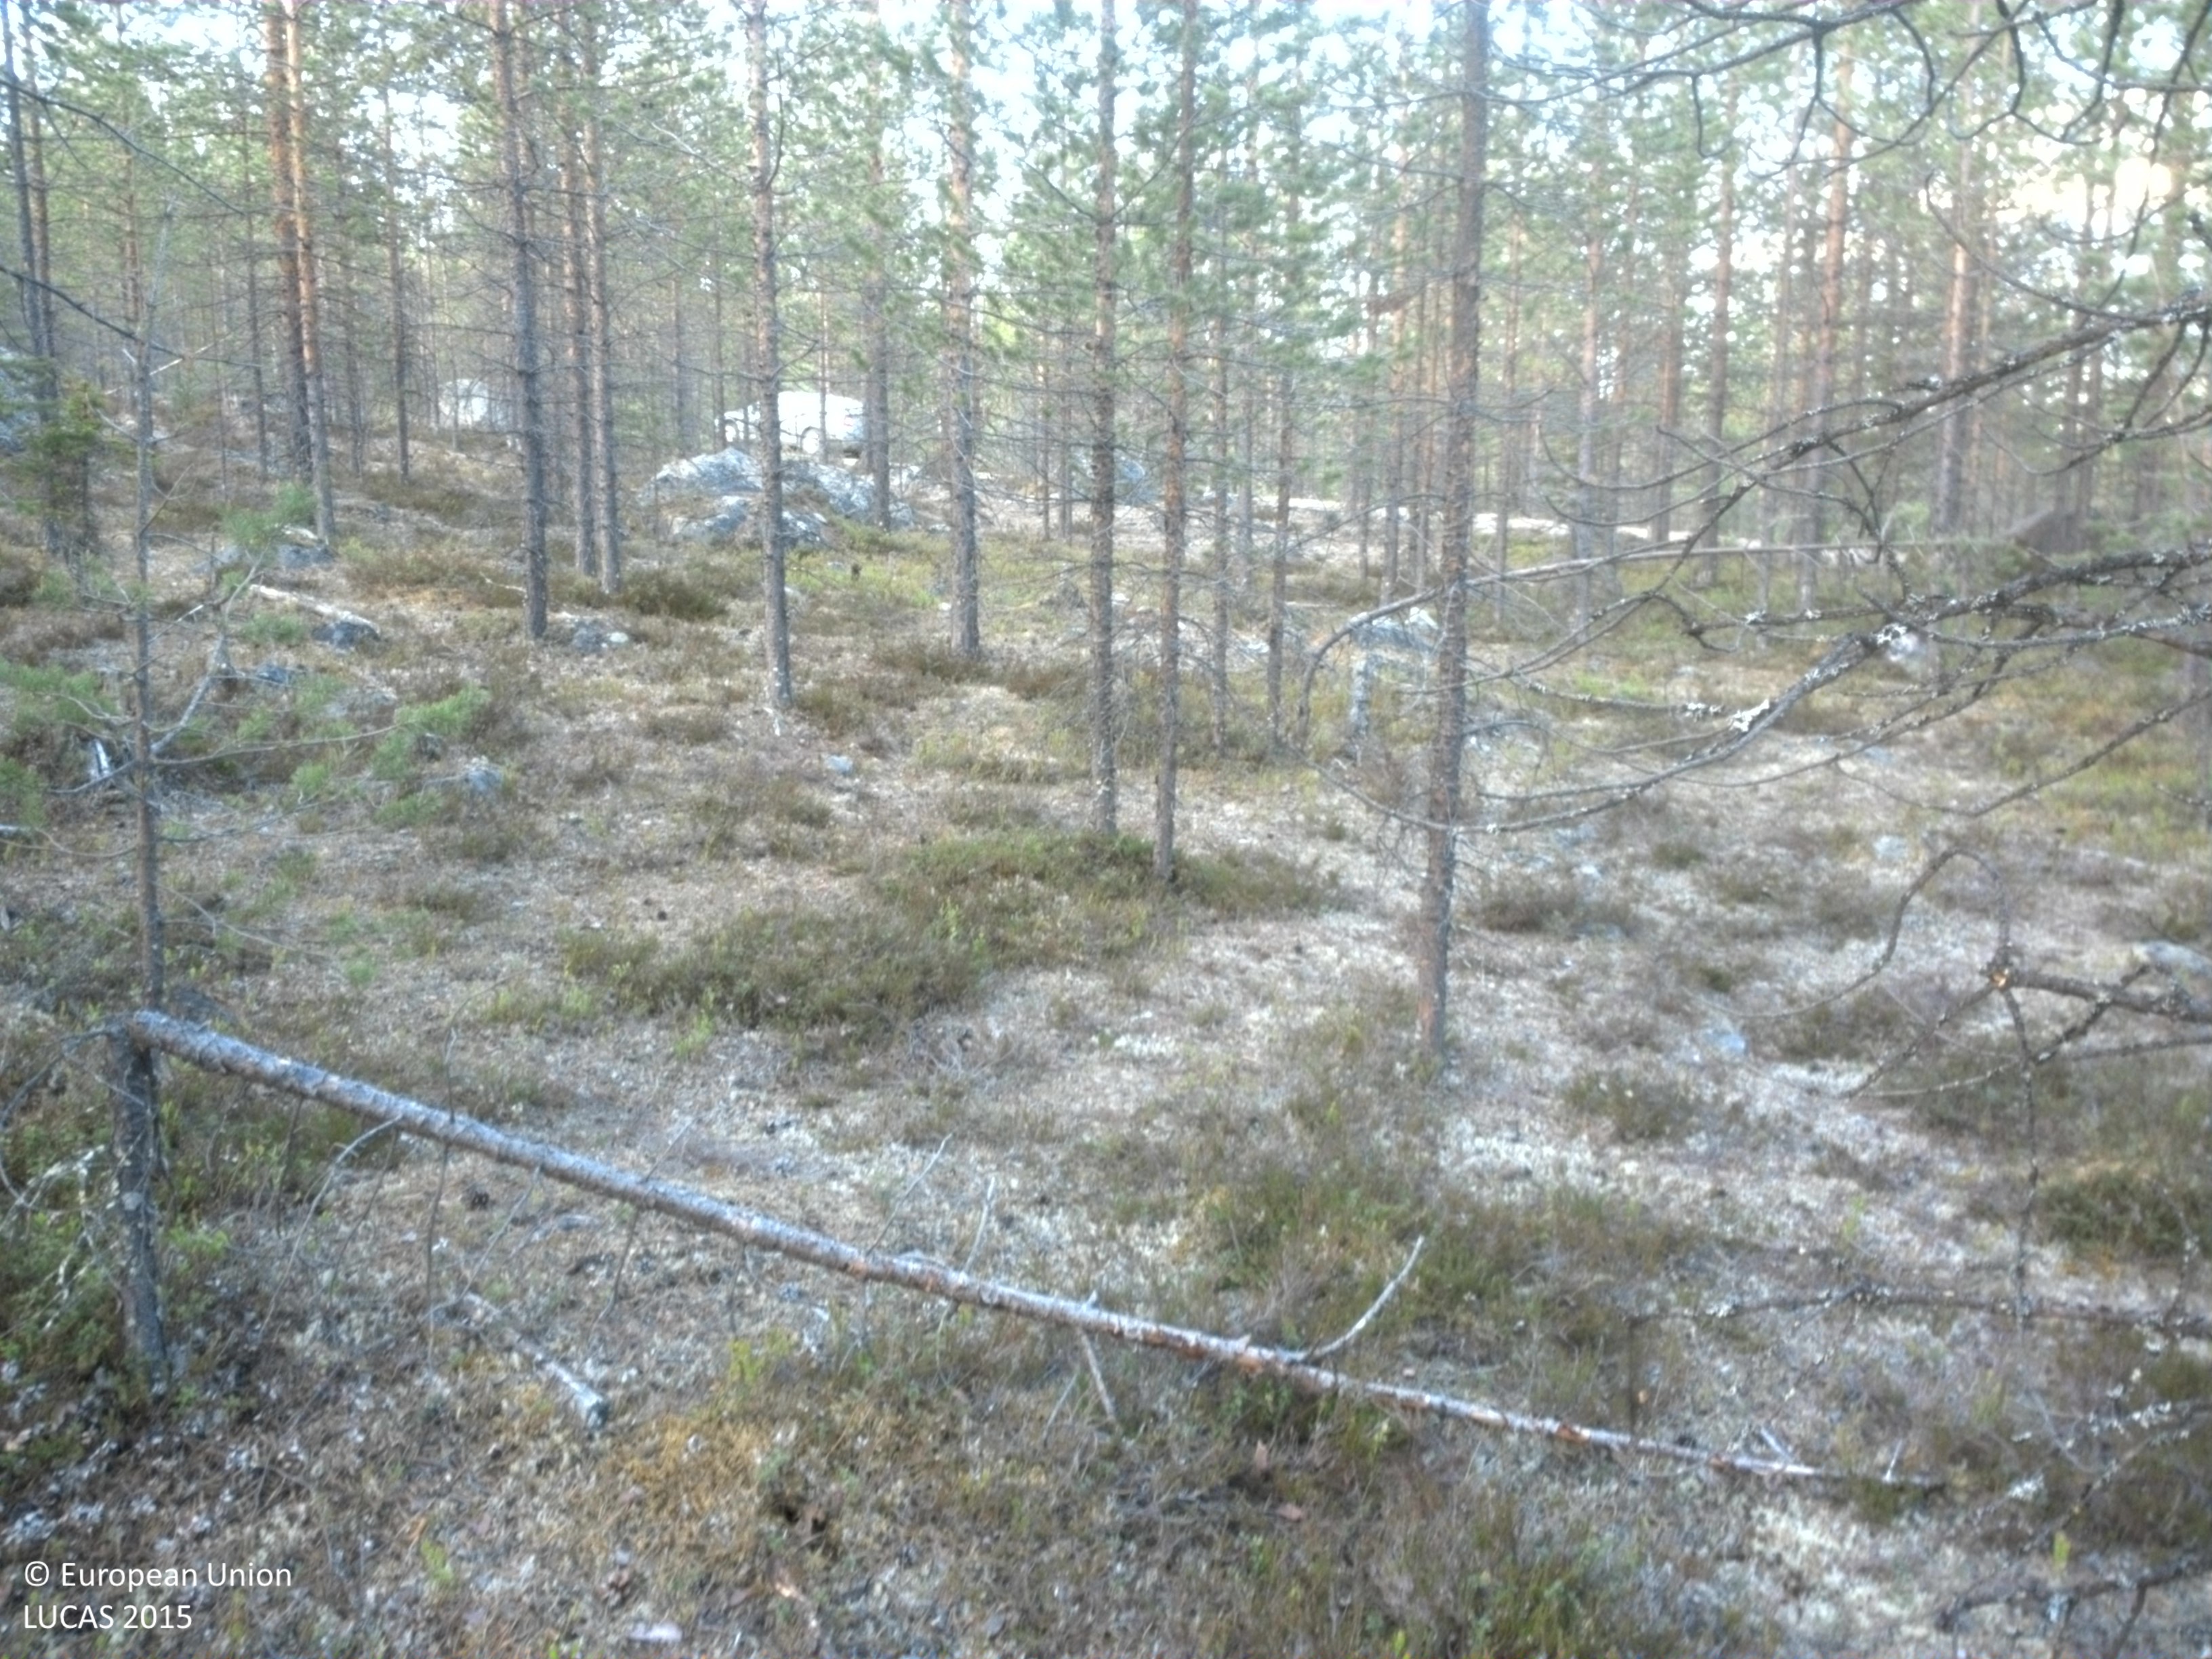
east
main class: Woodland
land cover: Pine dominated coniferous woodland
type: boreal forest
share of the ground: 25 - 50 %
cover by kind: shrubs 40 %, lichens and mosses 30 %, coniferous forest trees 25 %, unconsolidated bare surface 5 %
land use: Forestry
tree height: > 5 m
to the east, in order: Pine dominated coniferous woodland; Shruby margins; Paved roads, cycling and walking lanes; Pine dominated coniferous woodland; Pine dominated mixed woodland; Pine dominated coniferous woodland; Broadleaved woodland
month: June
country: SE
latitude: 66.9029
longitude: 21.8618
